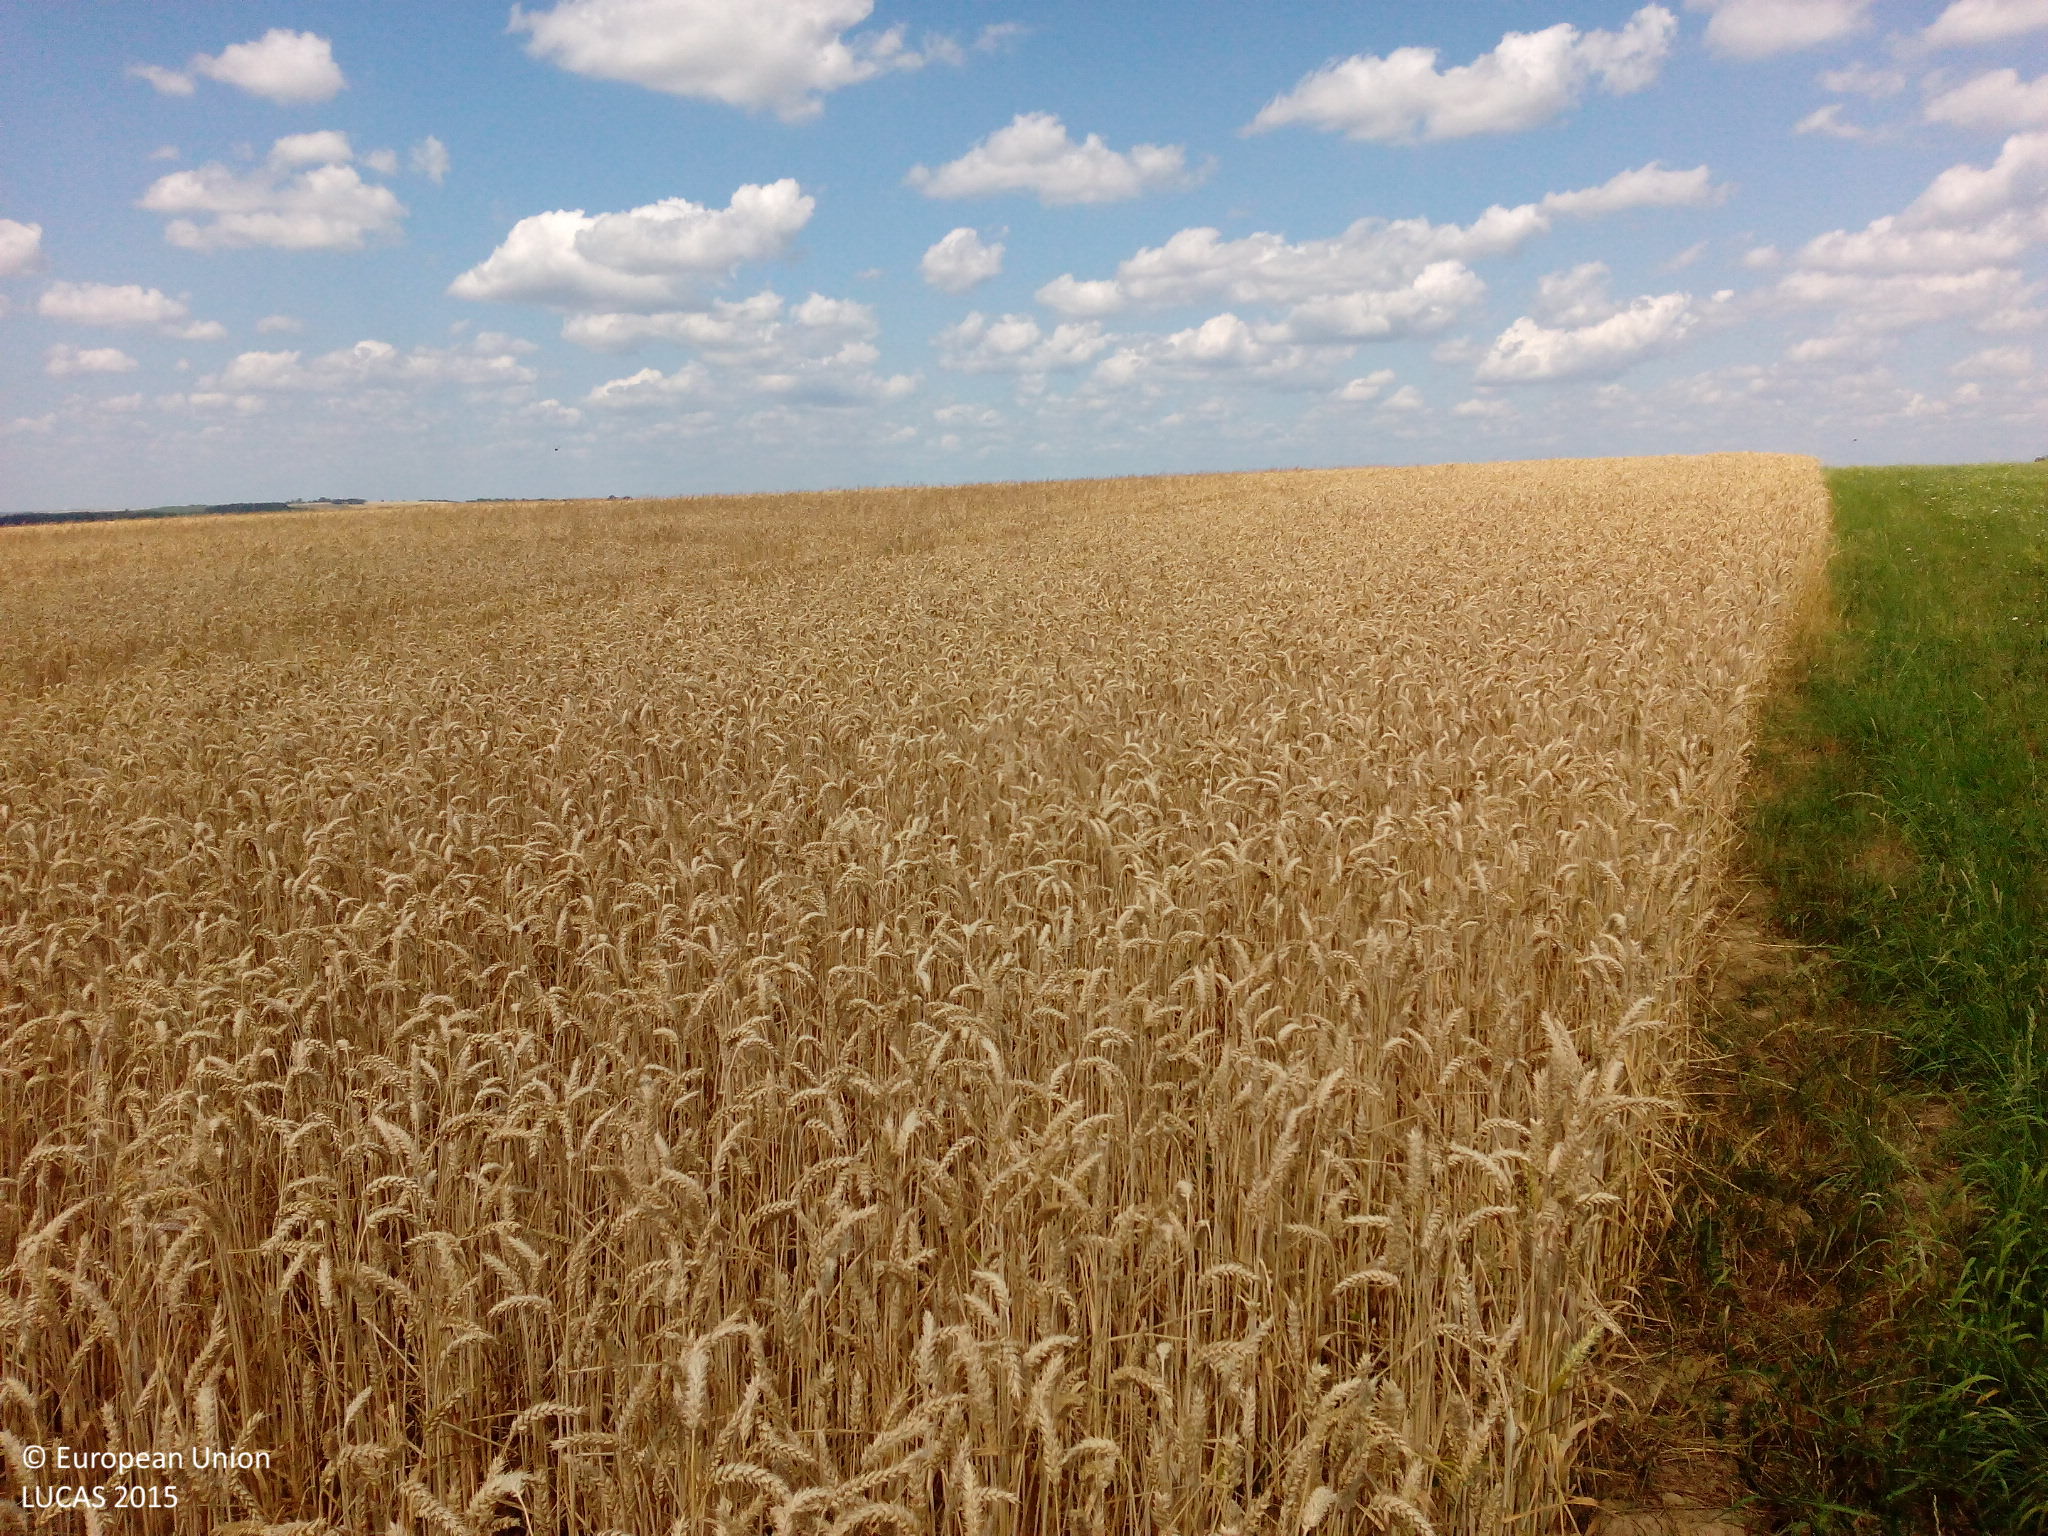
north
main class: Grassland
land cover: Grassland without tree/shrub cover
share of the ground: > 75 %
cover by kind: herbaceous plants 90 %, unconsolidated bare surface 10 %
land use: Agriculture (excluding fallow land and kitchen gardens)
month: July
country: DE
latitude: 49.2401
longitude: 7.5419
